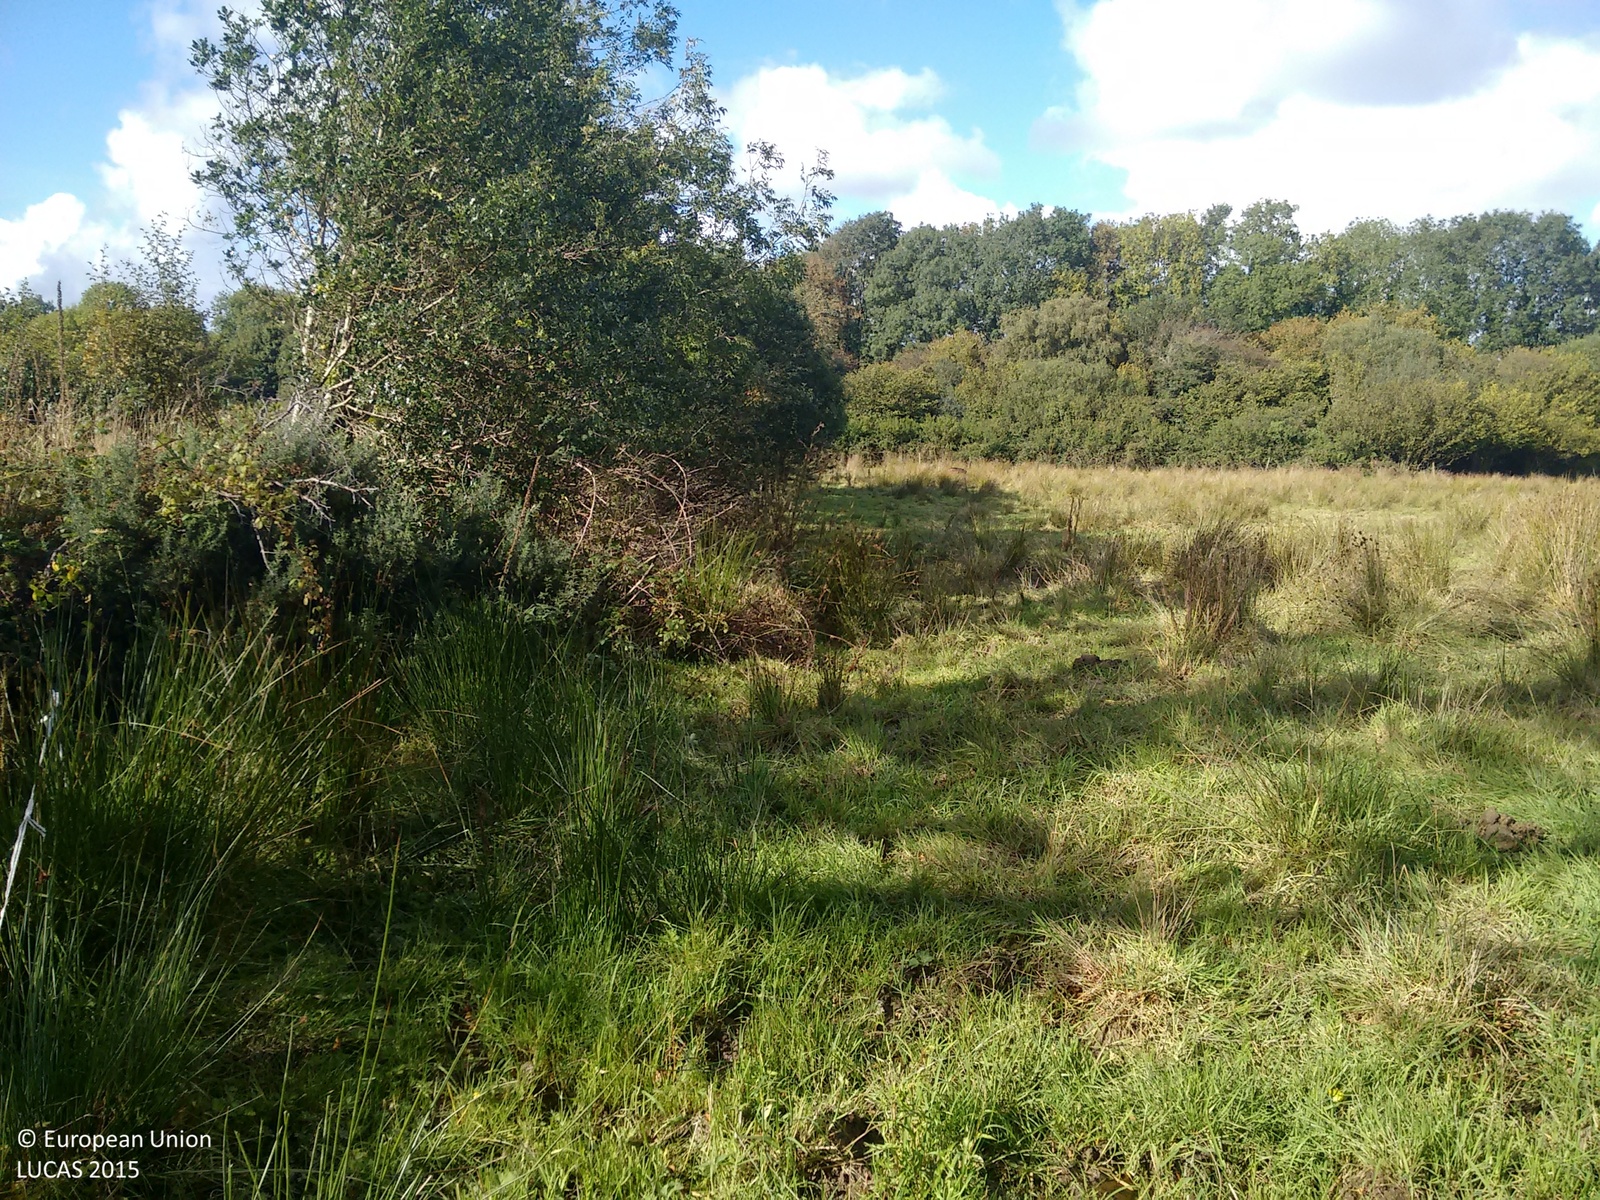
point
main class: Grassland
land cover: Grassland without tree/shrub cover
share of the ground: > 75 %
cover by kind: herbaceous plants 95 %, shrubs 5 %
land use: Agriculture (excluding fallow land and kitchen gardens)
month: September
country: IE
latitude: 52.4823
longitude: -9.4776
